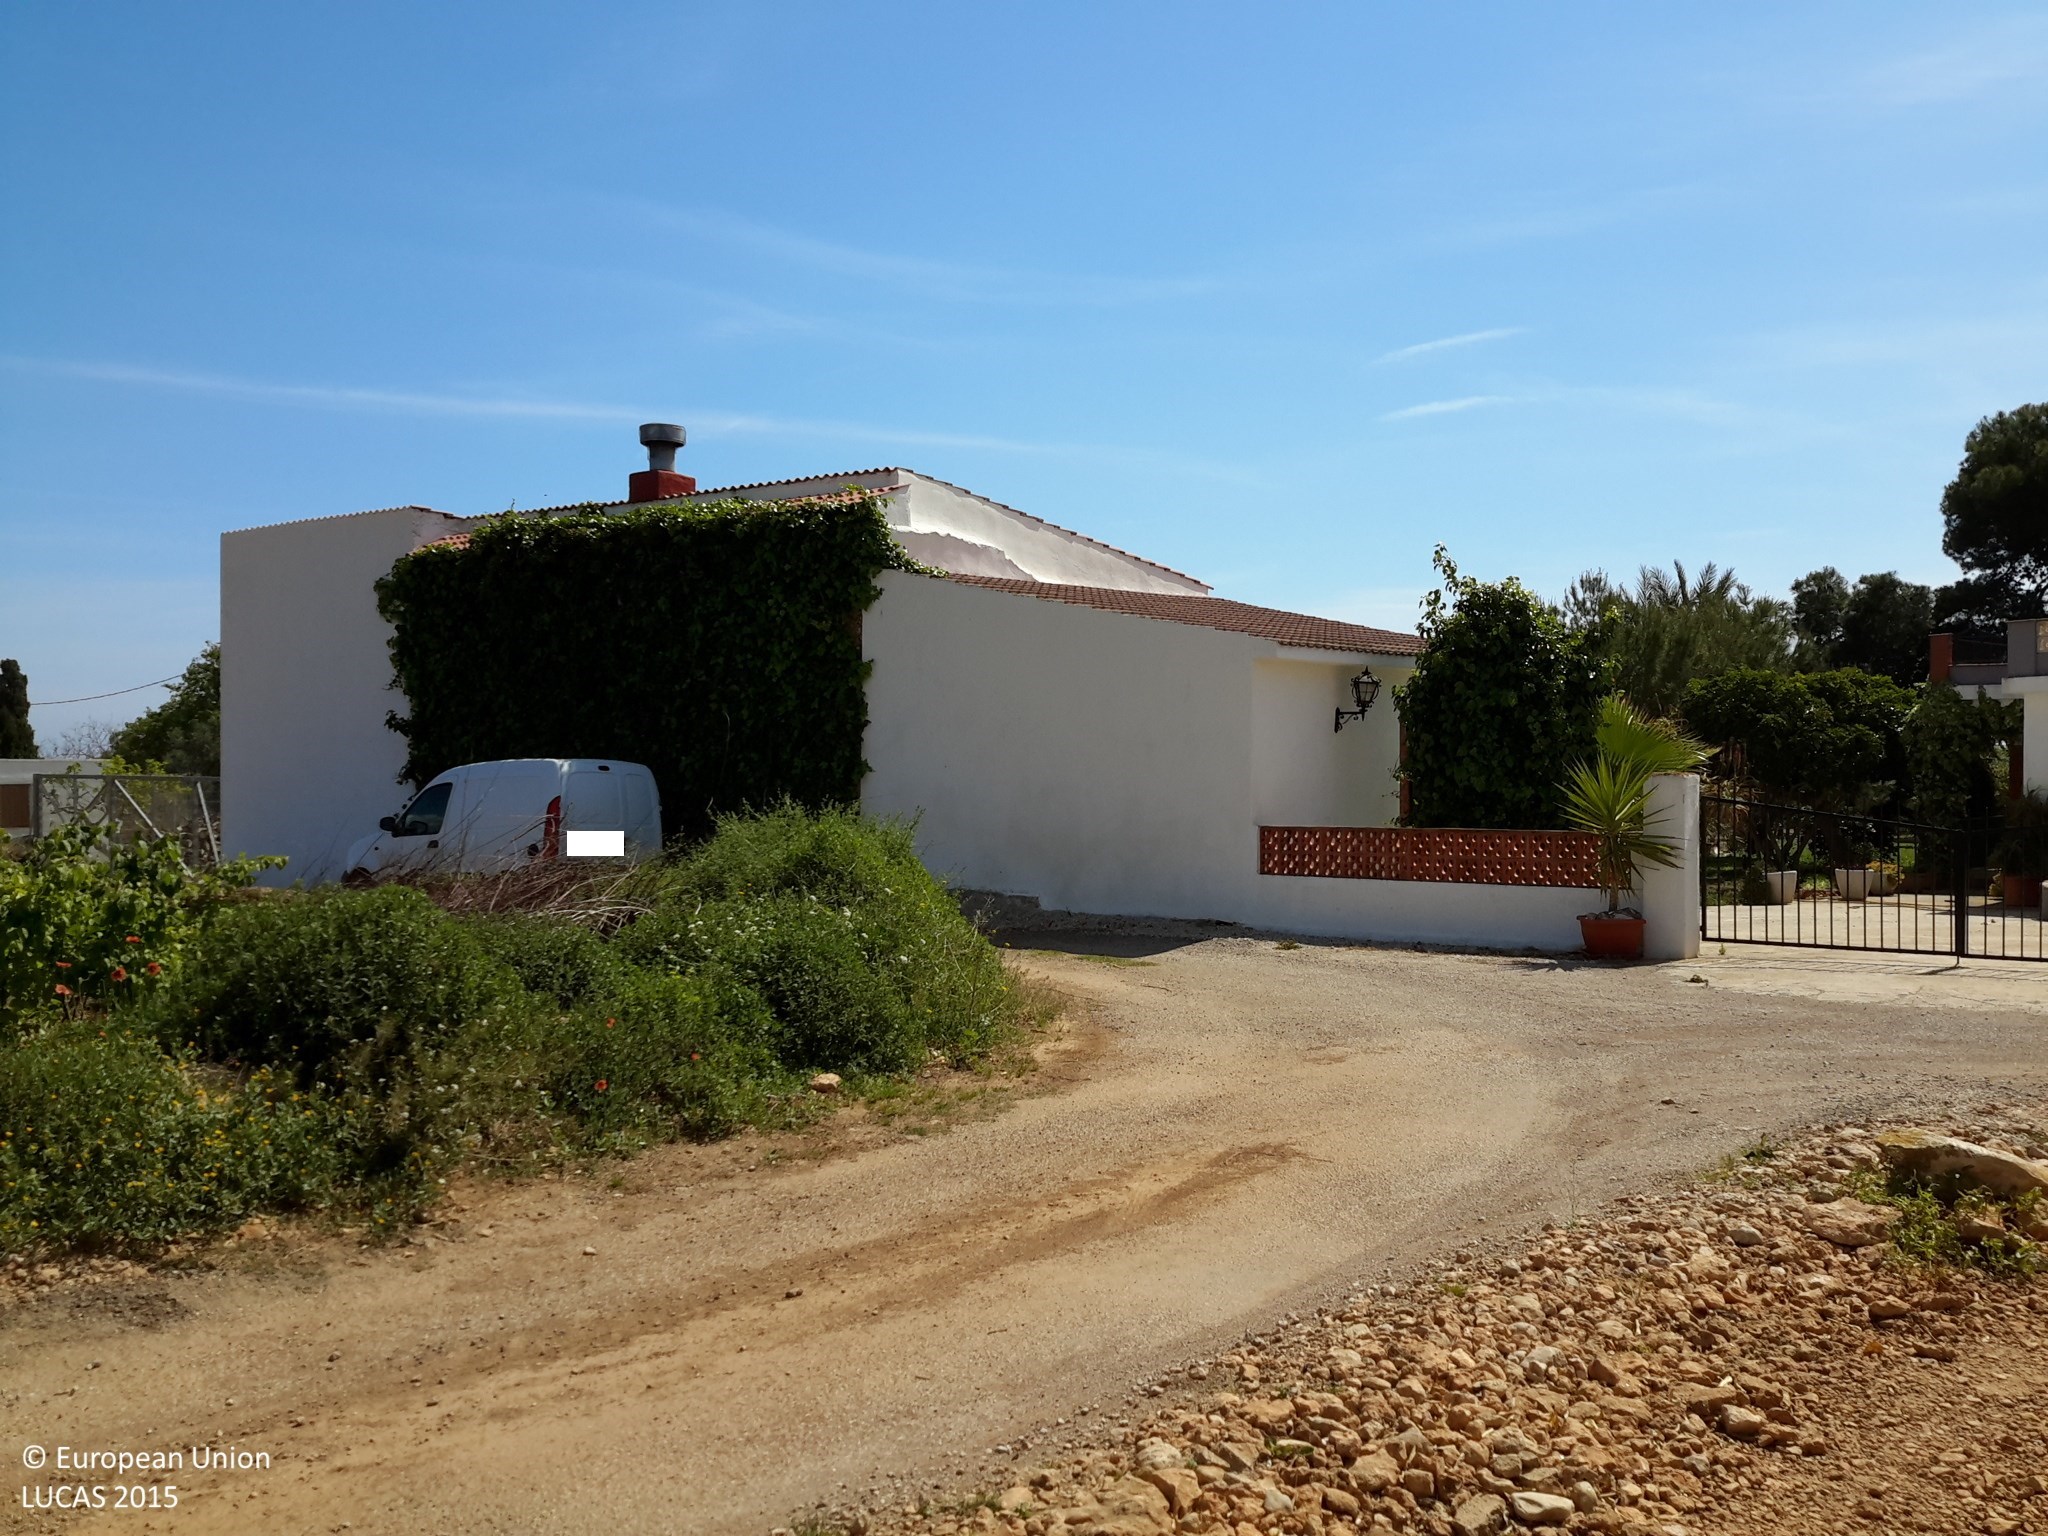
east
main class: Cropland
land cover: Oranges
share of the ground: 50 - 75 %
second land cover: Other bare soil
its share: > 75 %
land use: Agriculture (excluding fallow land and kitchen gardens)
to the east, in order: Oranges; Other bare soil; Tracks; Spontaneously vegetated surfaces; Tracks; Artificial constructions in urban areas; Other bare soil; Oranges; Fences; Artificial constructions; Tracks; Grassland with sparse tree/shrub cover; Electric lines; Grassland with sparse tree/shrub cover; Tomatoes; Artificial constructions in urban areas; Fences; Ditches and canals; Potatoes; Fences; Paved roads, cycling and walking lanes; Rocks and stones
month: April
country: ES
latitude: 40.5351
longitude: 0.5161
